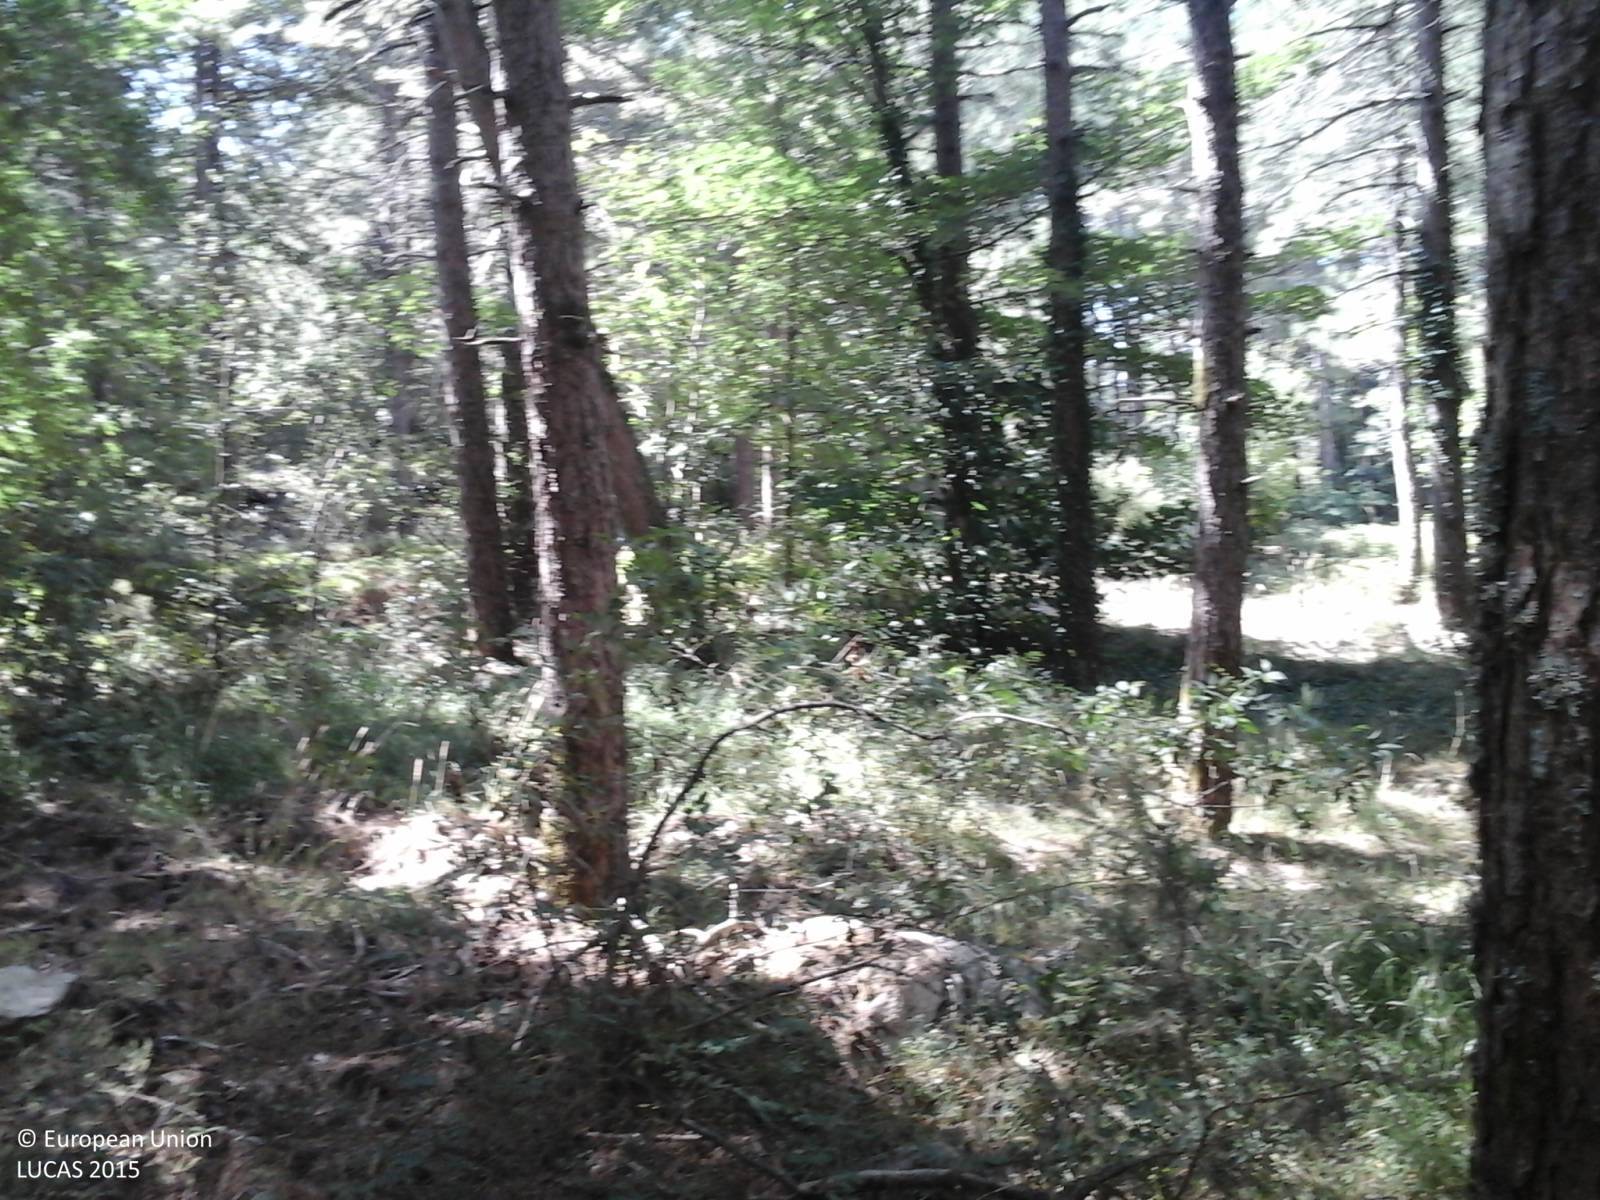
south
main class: Woodland
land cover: Pine dominated coniferous woodland
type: coniferous forest of the mediterranean region
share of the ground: > 75 %
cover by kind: herbaceous plants 80 %, coniferous forest trees 10 %, shrubs 10 %
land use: Forestry
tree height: > 5 m
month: August
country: IT
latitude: 40.8610
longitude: 9.1617
